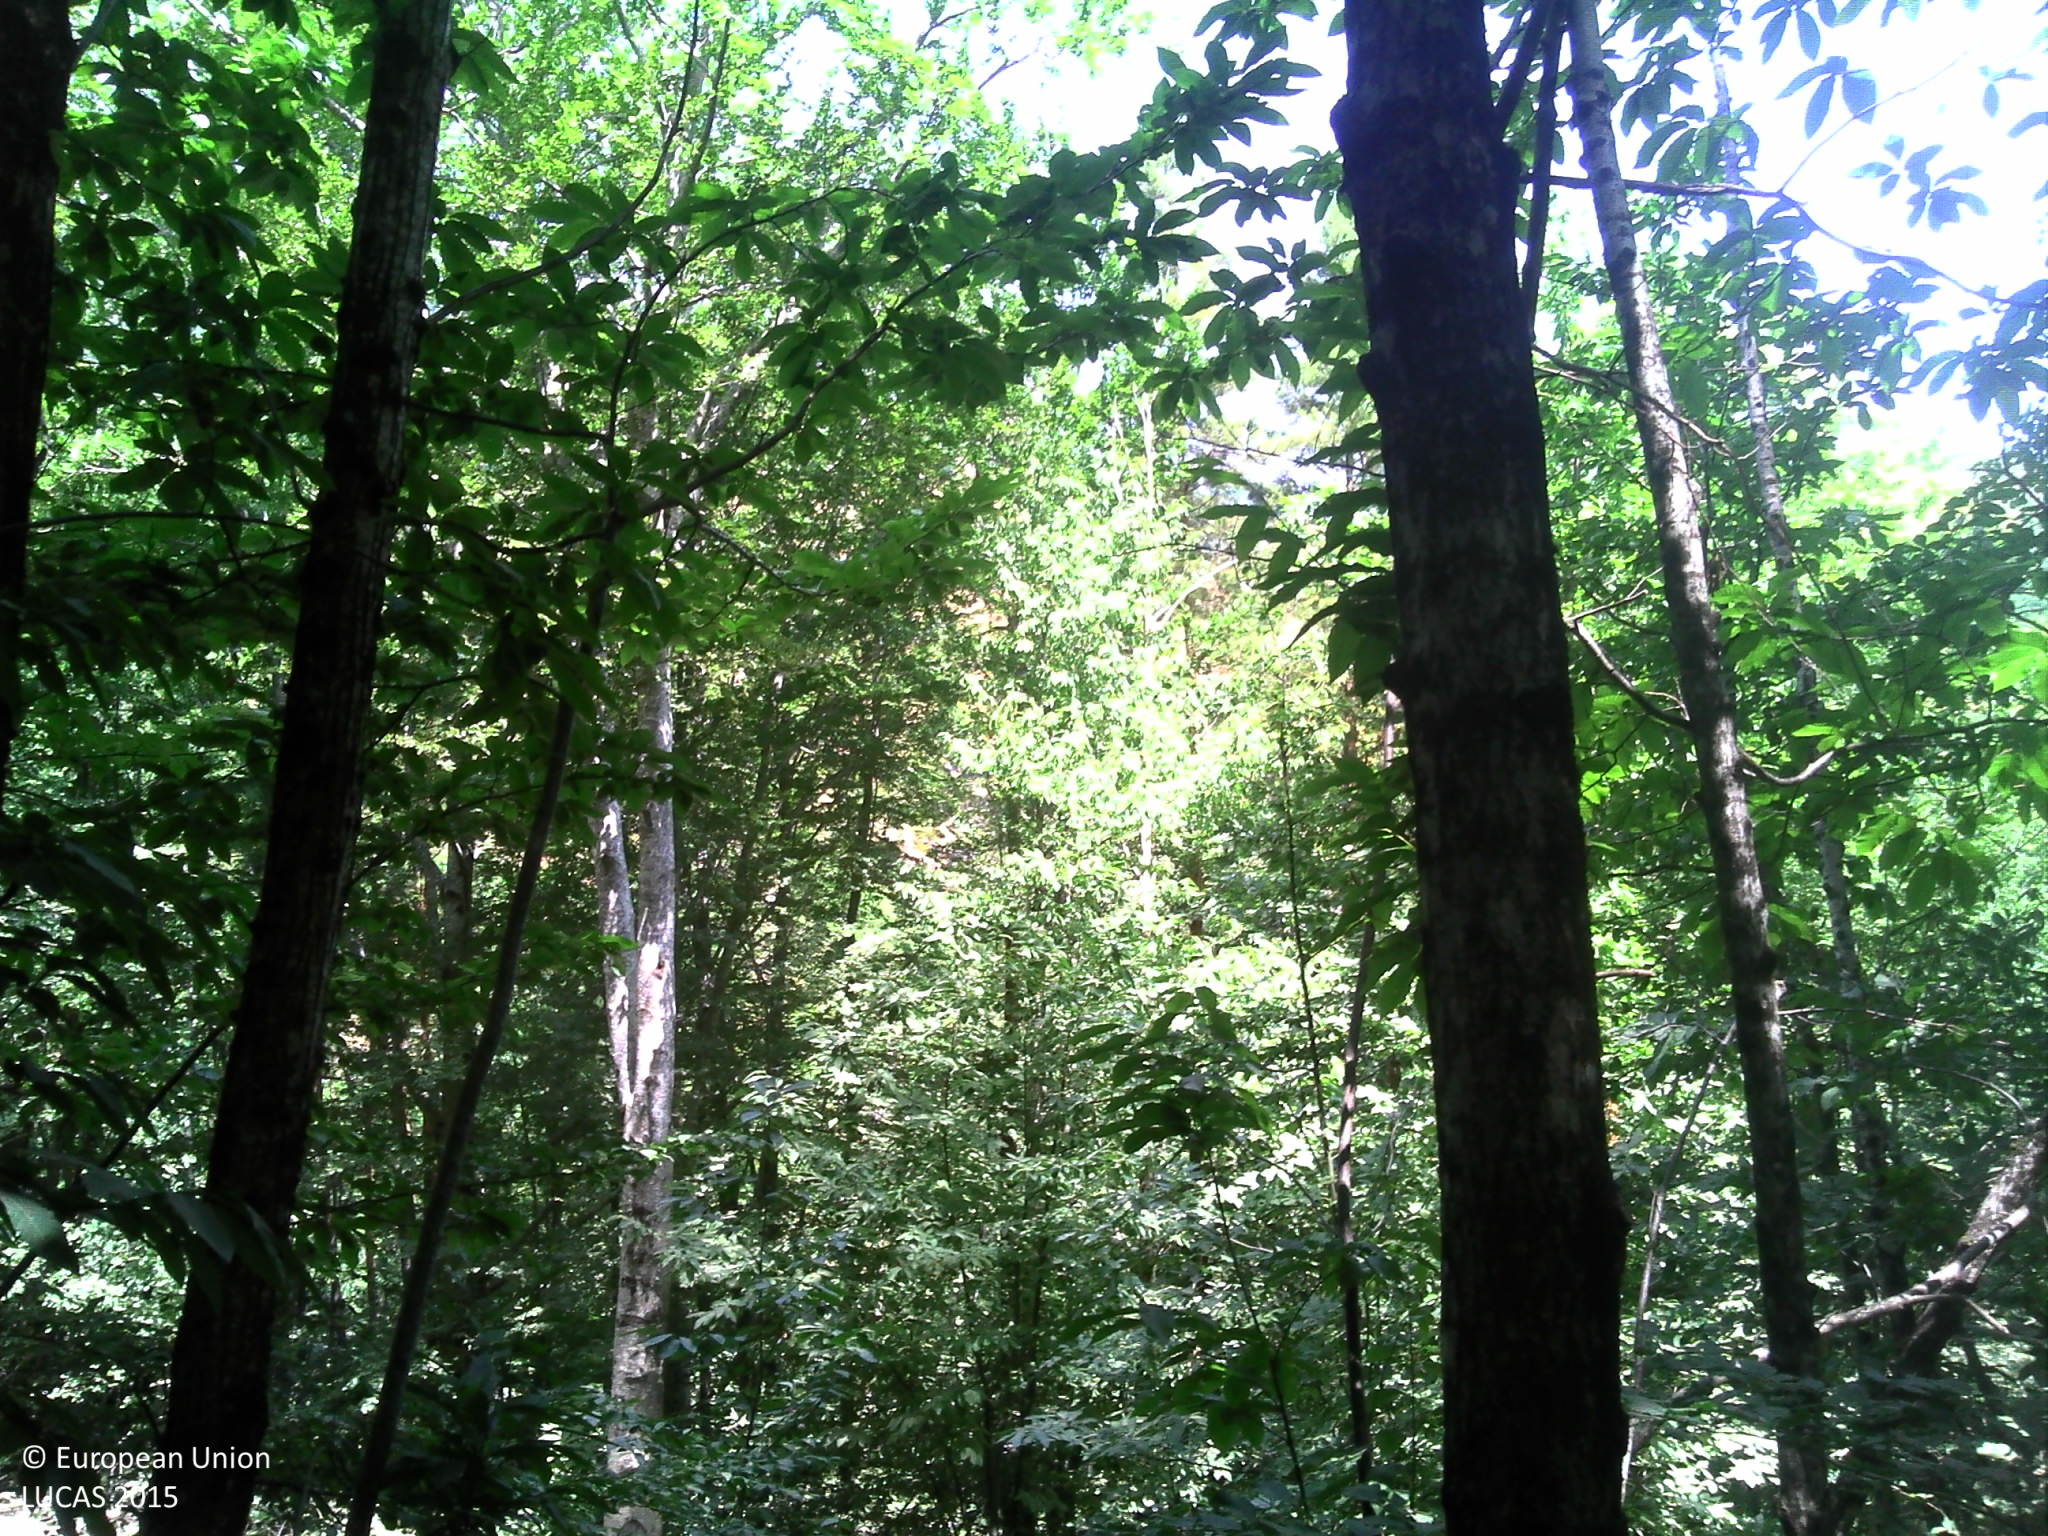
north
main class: Woodland
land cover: Broadleaved woodland
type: beech forest
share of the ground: > 75 %
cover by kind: broadleaved forest trees 85 %, unconsolidated bare surface 10 %, coniferous forest trees 5 %
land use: Forestry
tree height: > 5 m
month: July
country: FR
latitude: 44.2228
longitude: 3.5597
